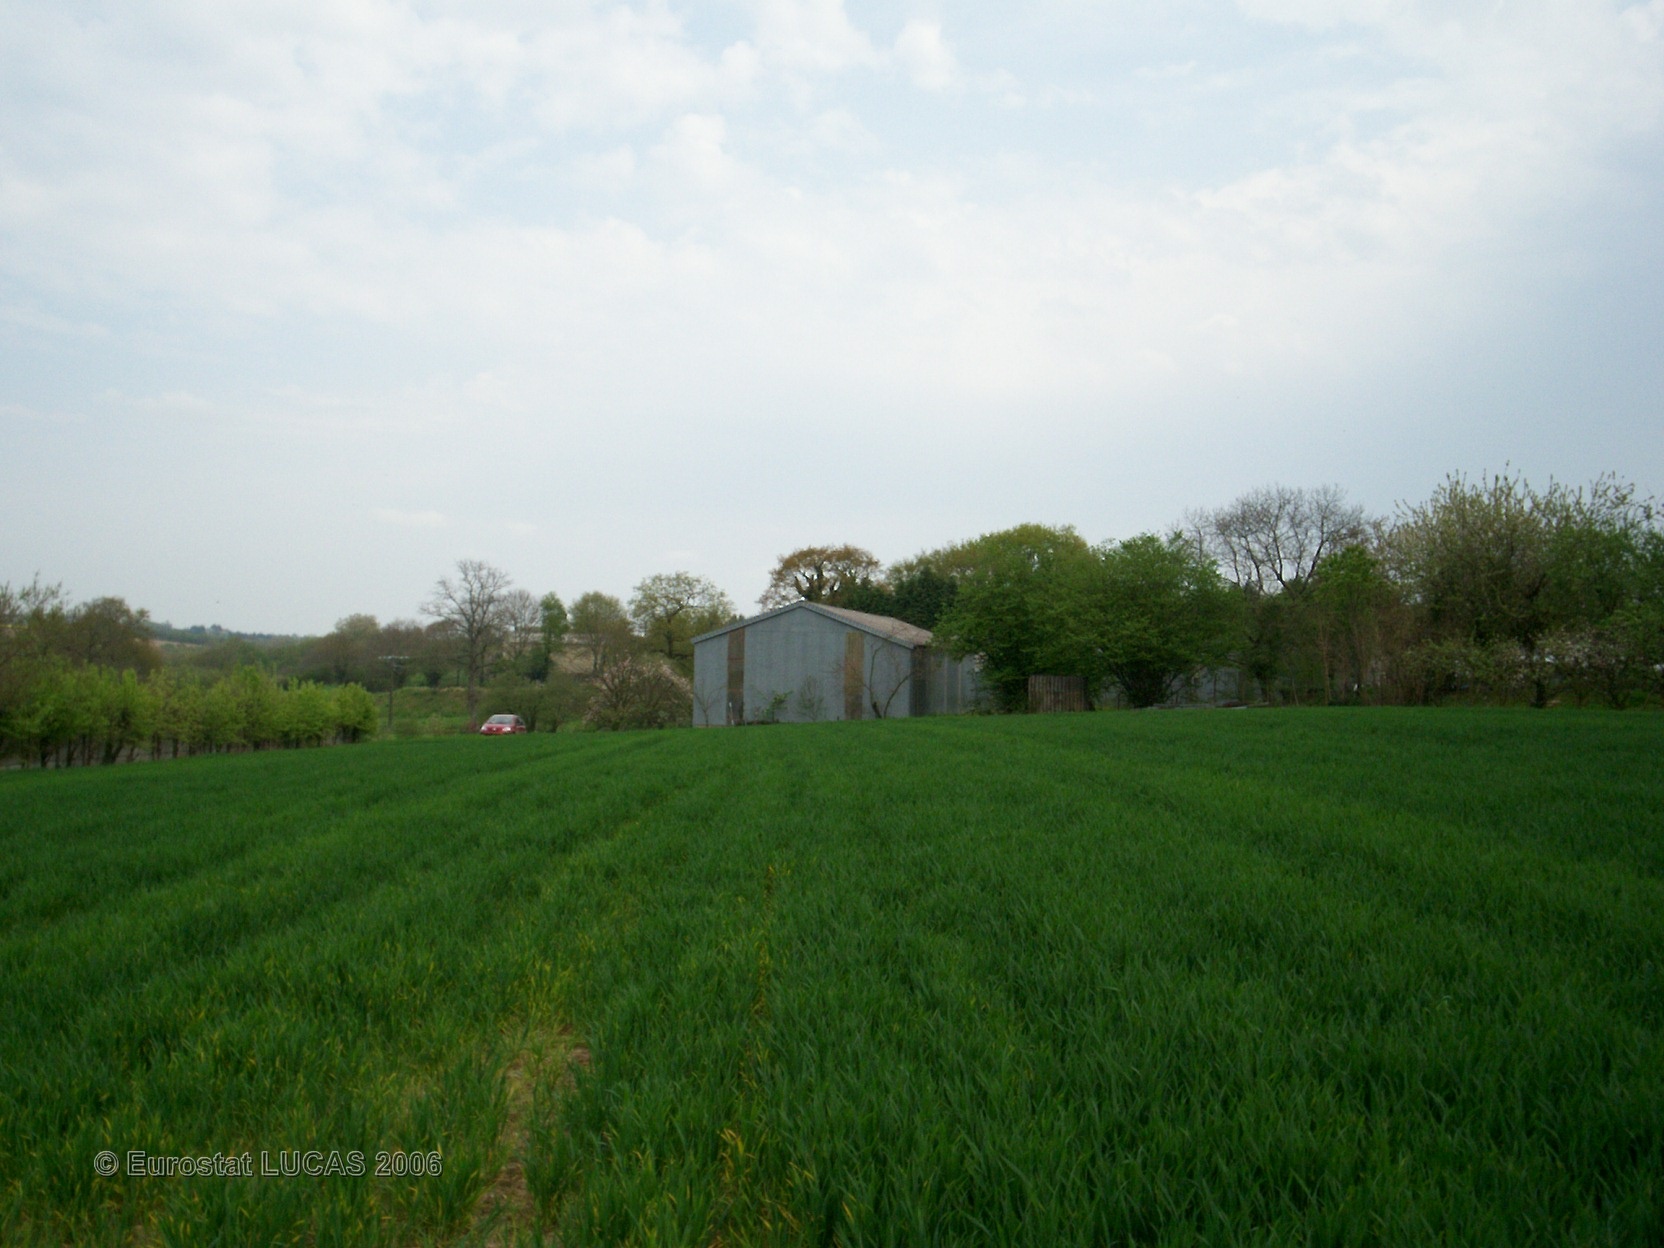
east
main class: Cropland
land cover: Common wheat
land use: Agriculture (excluding fallow land and kitchen gardens)
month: May
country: FR
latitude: 47.8477
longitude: -2.7174
